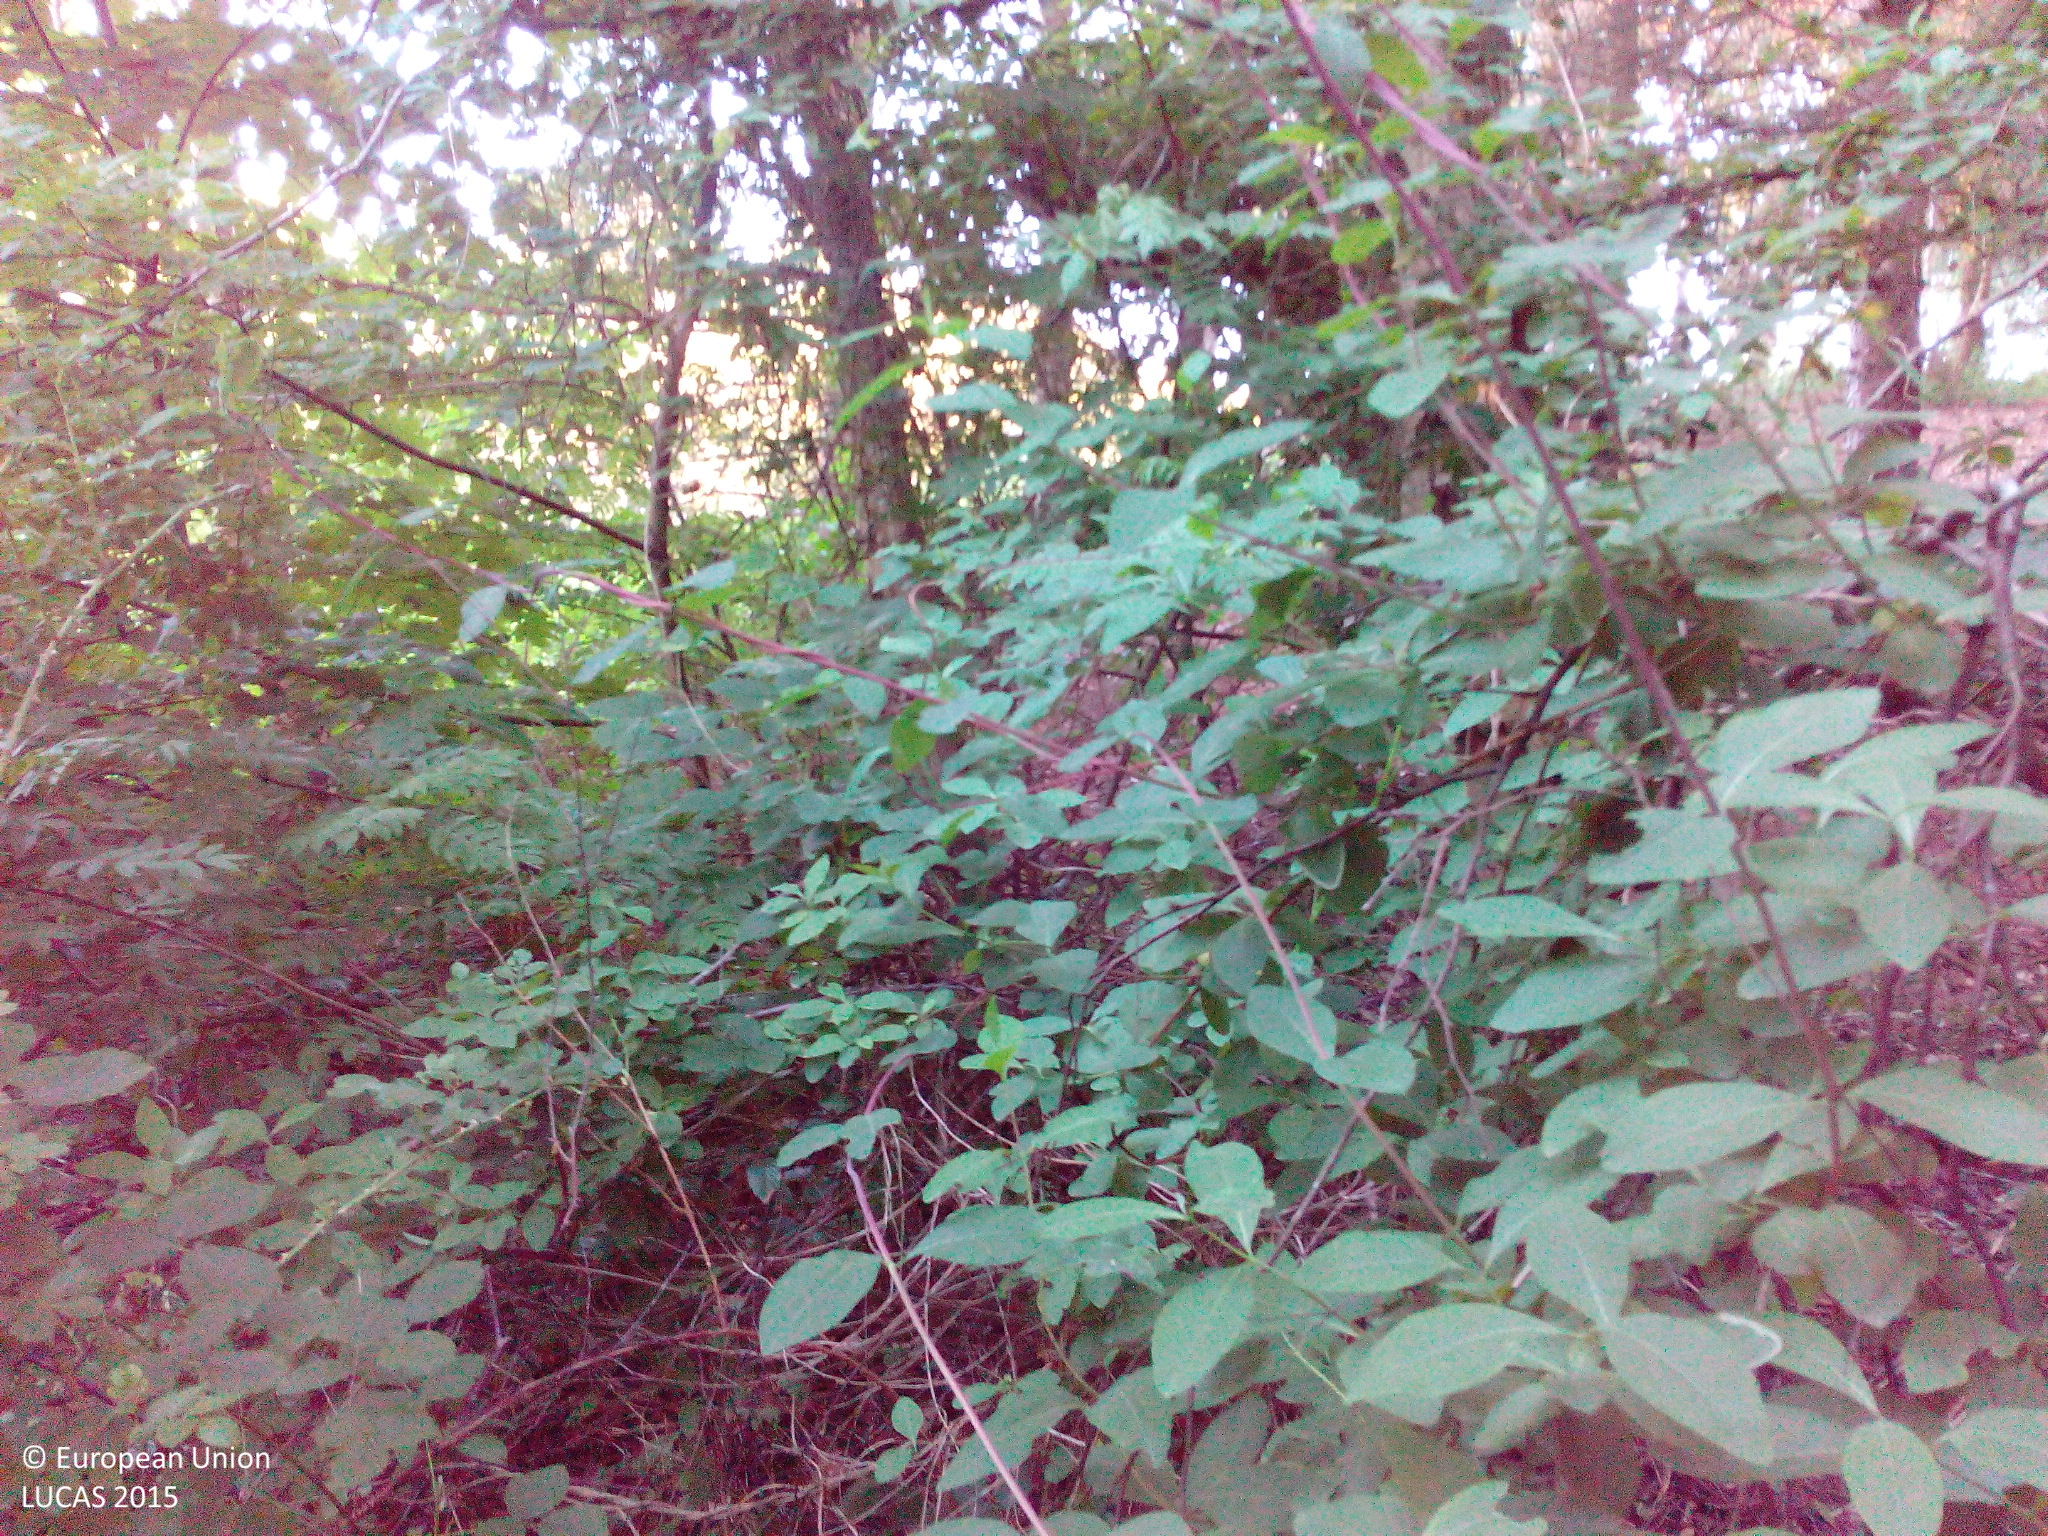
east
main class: Woodland
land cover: Broadleaved woodland
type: mesophytic deciduous forest
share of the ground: 50 - 75 %
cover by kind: broadleaved forest trees 70 %, shrubs 10 %, herbaceous plants 10 %
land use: Forestry
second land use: Amenities, museums, leisure
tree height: > 5 m
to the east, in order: Broadleaved woodland; Spruce dominated coniferous woodland; Shrubland with sparse tree cover; Other mixed woodland; Paved roads, cycling and walking lanes; Broadleaved woodland
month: July
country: DK
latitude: 56.5272
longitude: 10.7306
